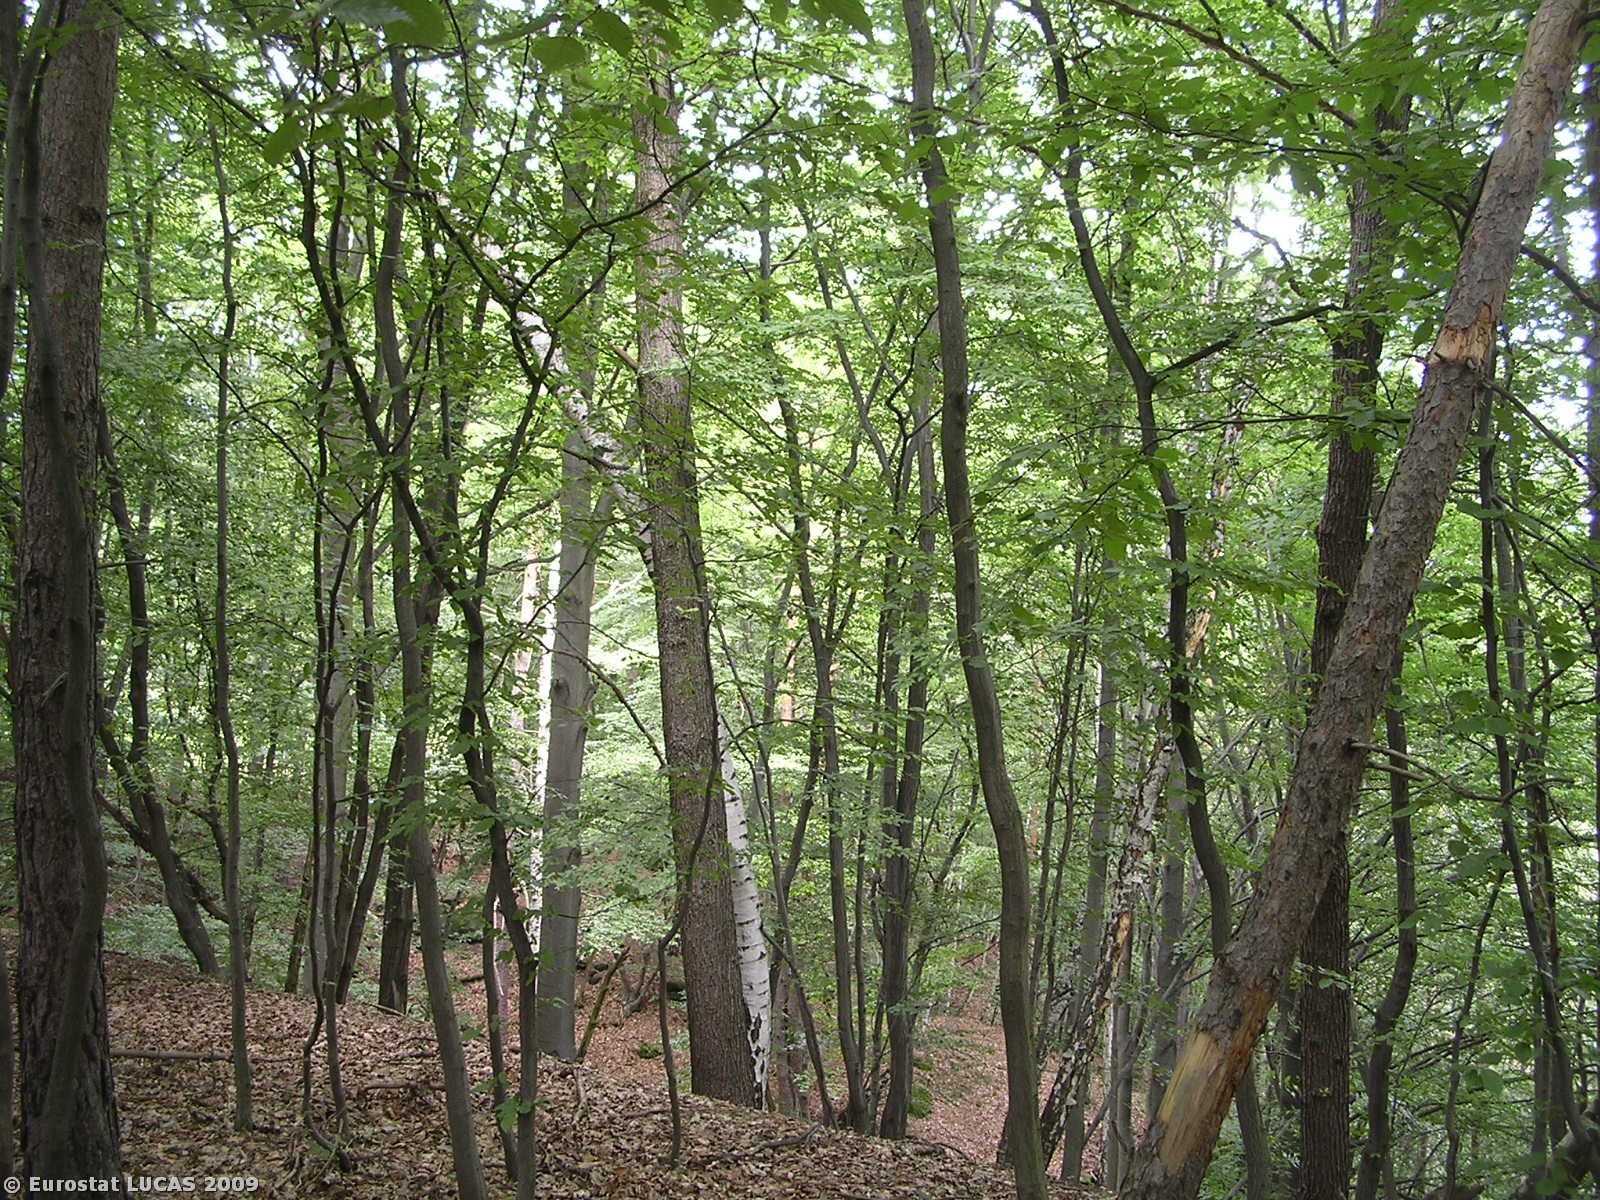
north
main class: Woodland
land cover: Mixed woodland
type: hemiboreal forest and nemoral coniferous forest and mixed broadleaved-coniferous forest
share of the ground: > 75 %
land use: Forestry
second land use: Nature reserves
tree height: > 5 m
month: June
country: CZ
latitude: 50.4682
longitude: 14.6373
